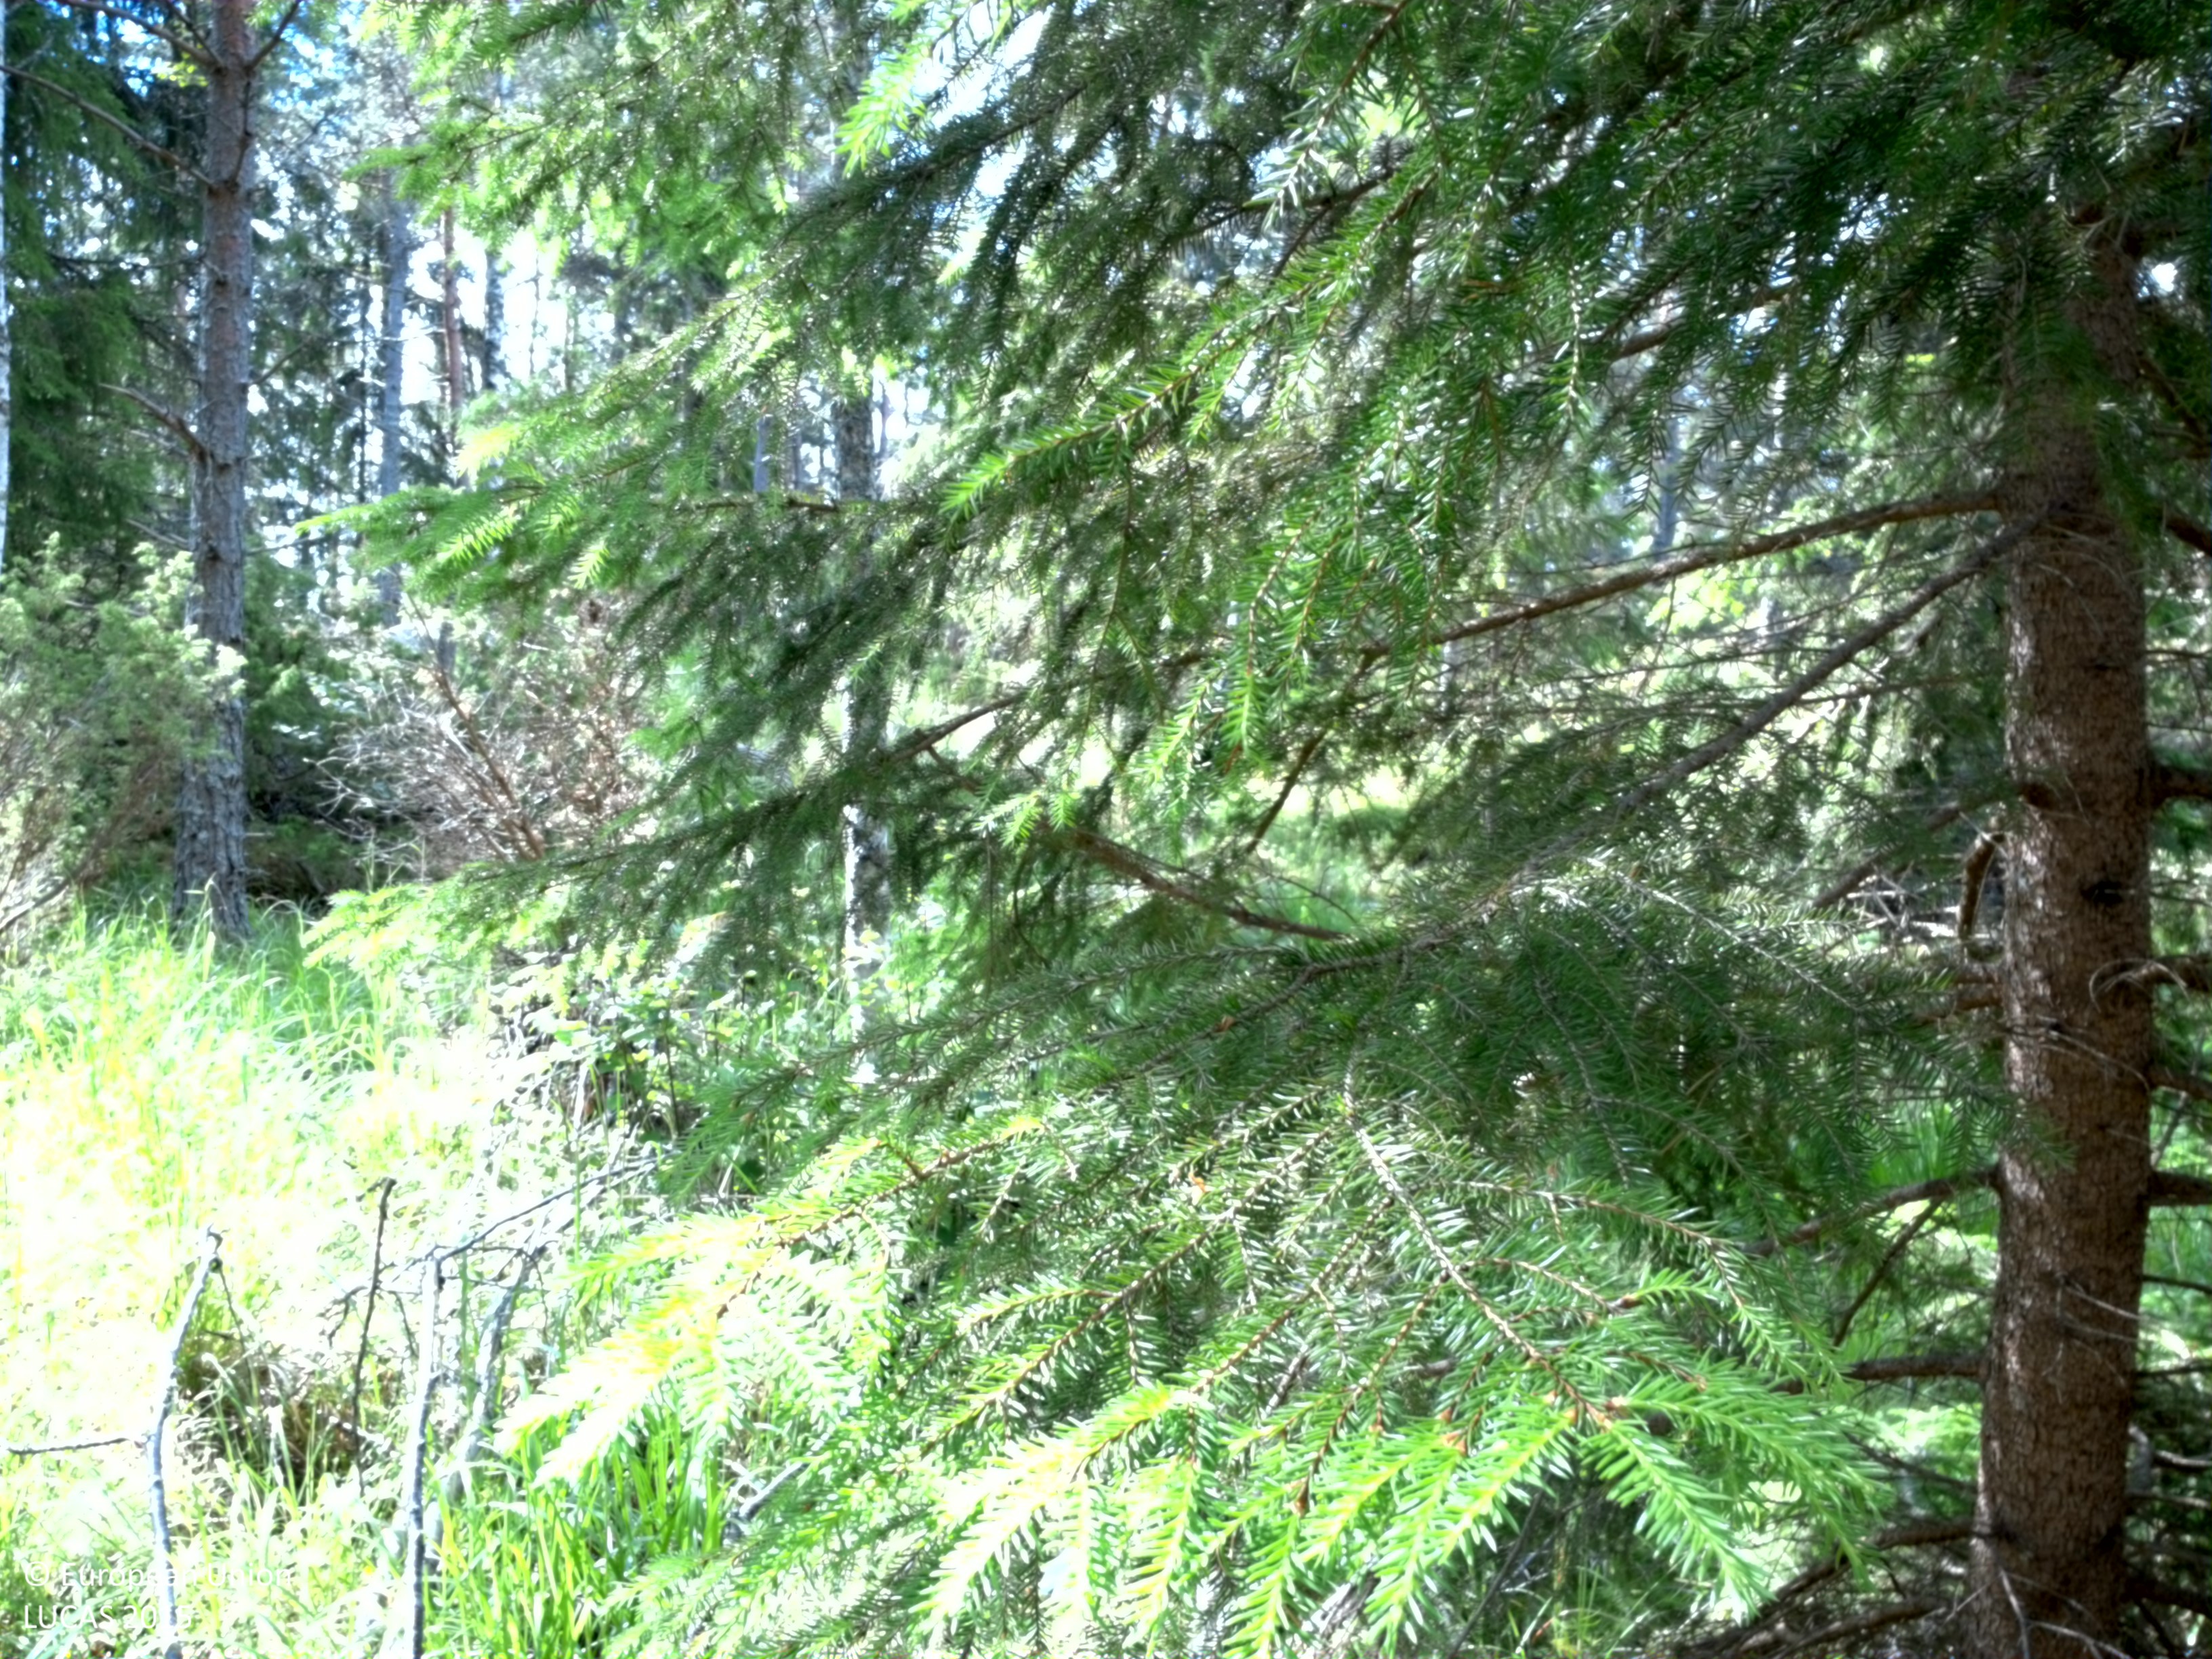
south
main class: Woodland
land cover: Pine dominated mixed woodland
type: boreal forest
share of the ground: 50 - 75 %
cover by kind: coniferous forest trees 45 %, herbaceous plants 25 %, broadleaved forest trees 15 %, lichens and mosses 15 %
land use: Forestry
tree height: > 5 m
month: June
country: SE
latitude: 60.1091
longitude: 18.4338
